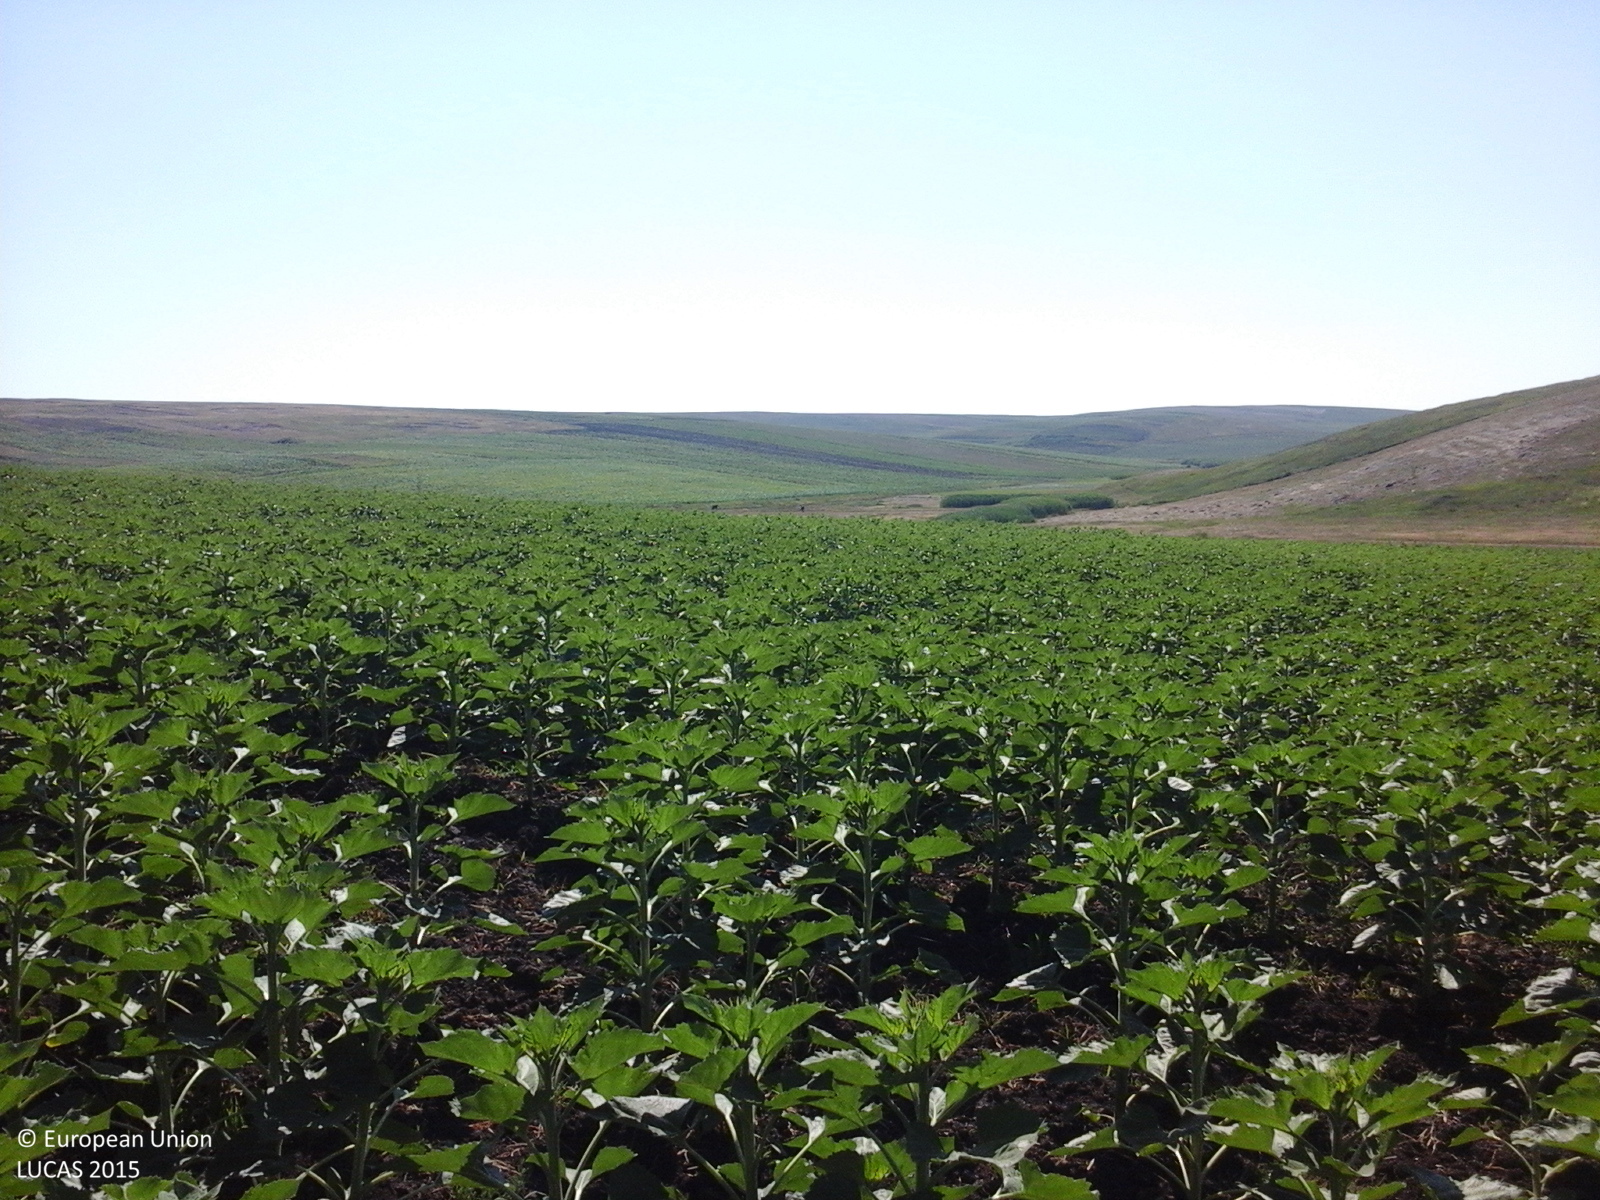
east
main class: Cropland
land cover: Sunflower
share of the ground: 50 - 75 %
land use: Agriculture (excluding fallow land and kitchen gardens)
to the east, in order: Sunflower; Maize; Grassland without tree/shrub cover
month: June
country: RO
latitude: 47.3713
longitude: 27.0958
